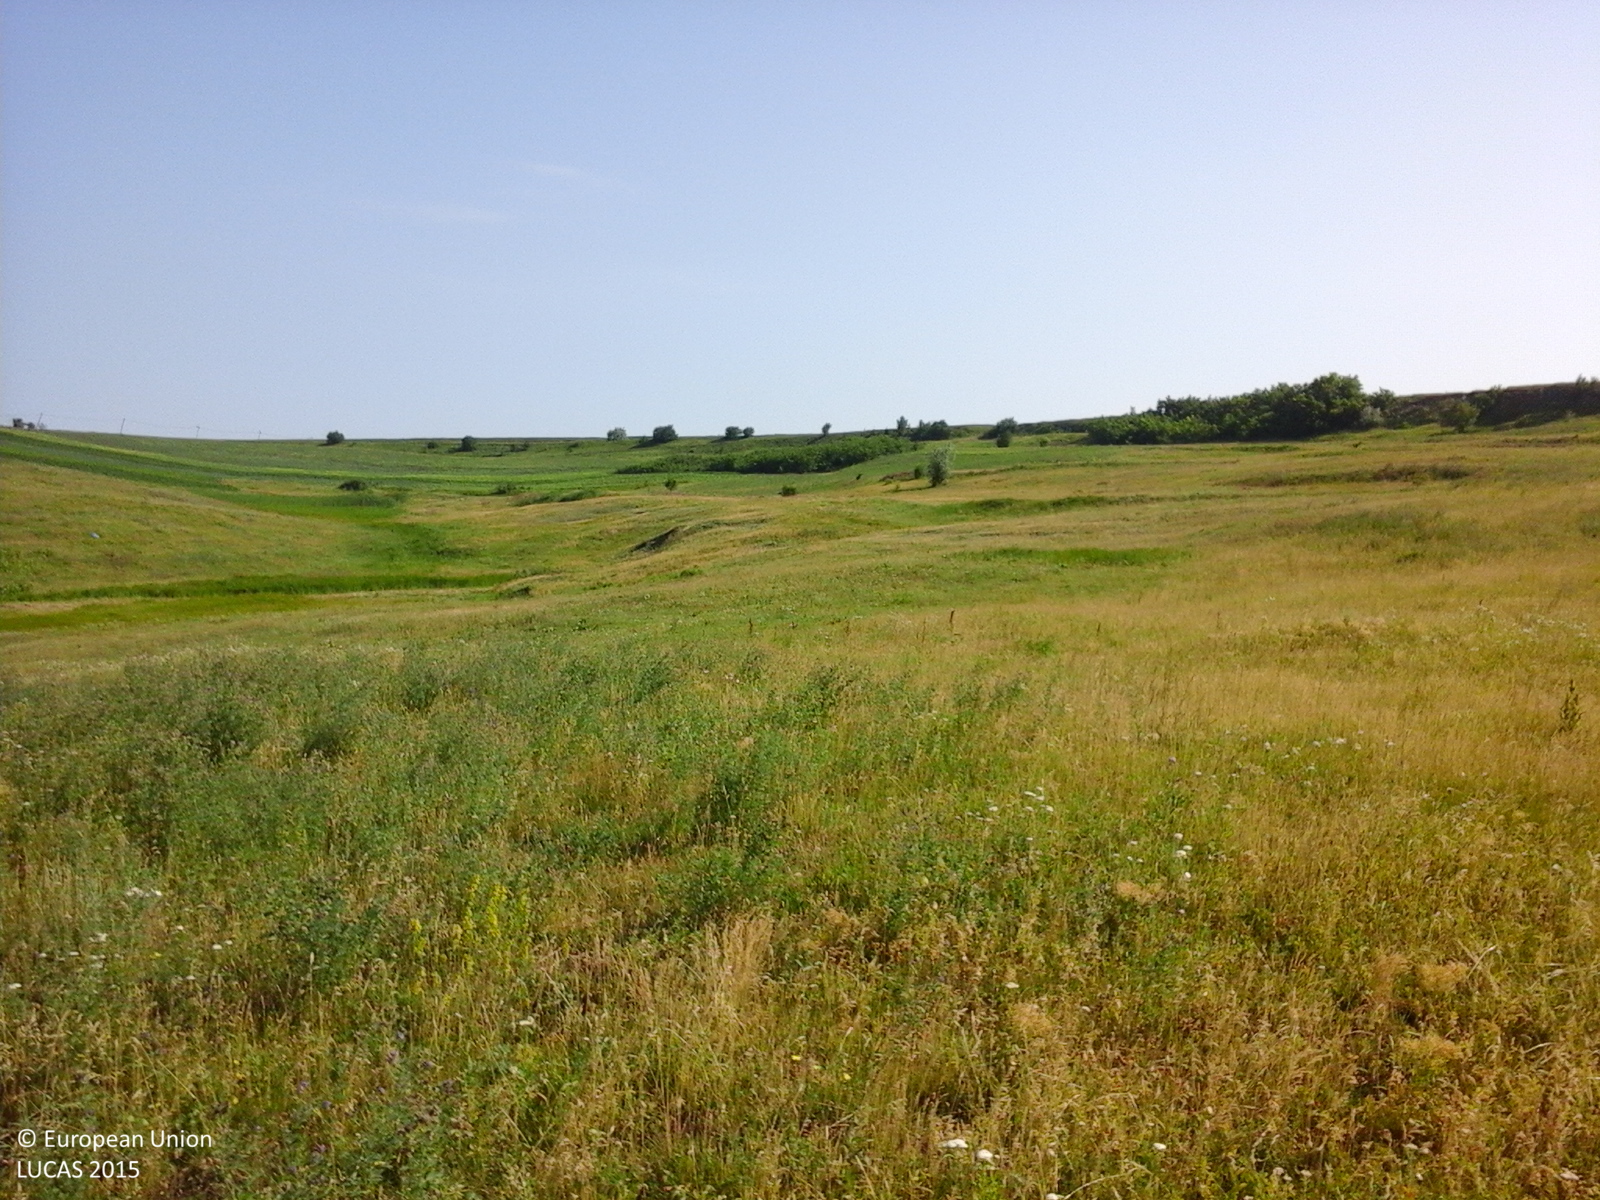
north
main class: Grassland
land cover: Grassland without tree/shrub cover
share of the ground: > 75 %
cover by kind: herbaceous plants 100 %
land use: Agriculture (excluding fallow land and kitchen gardens)
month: June
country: RO
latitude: 47.9542
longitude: 26.6607
